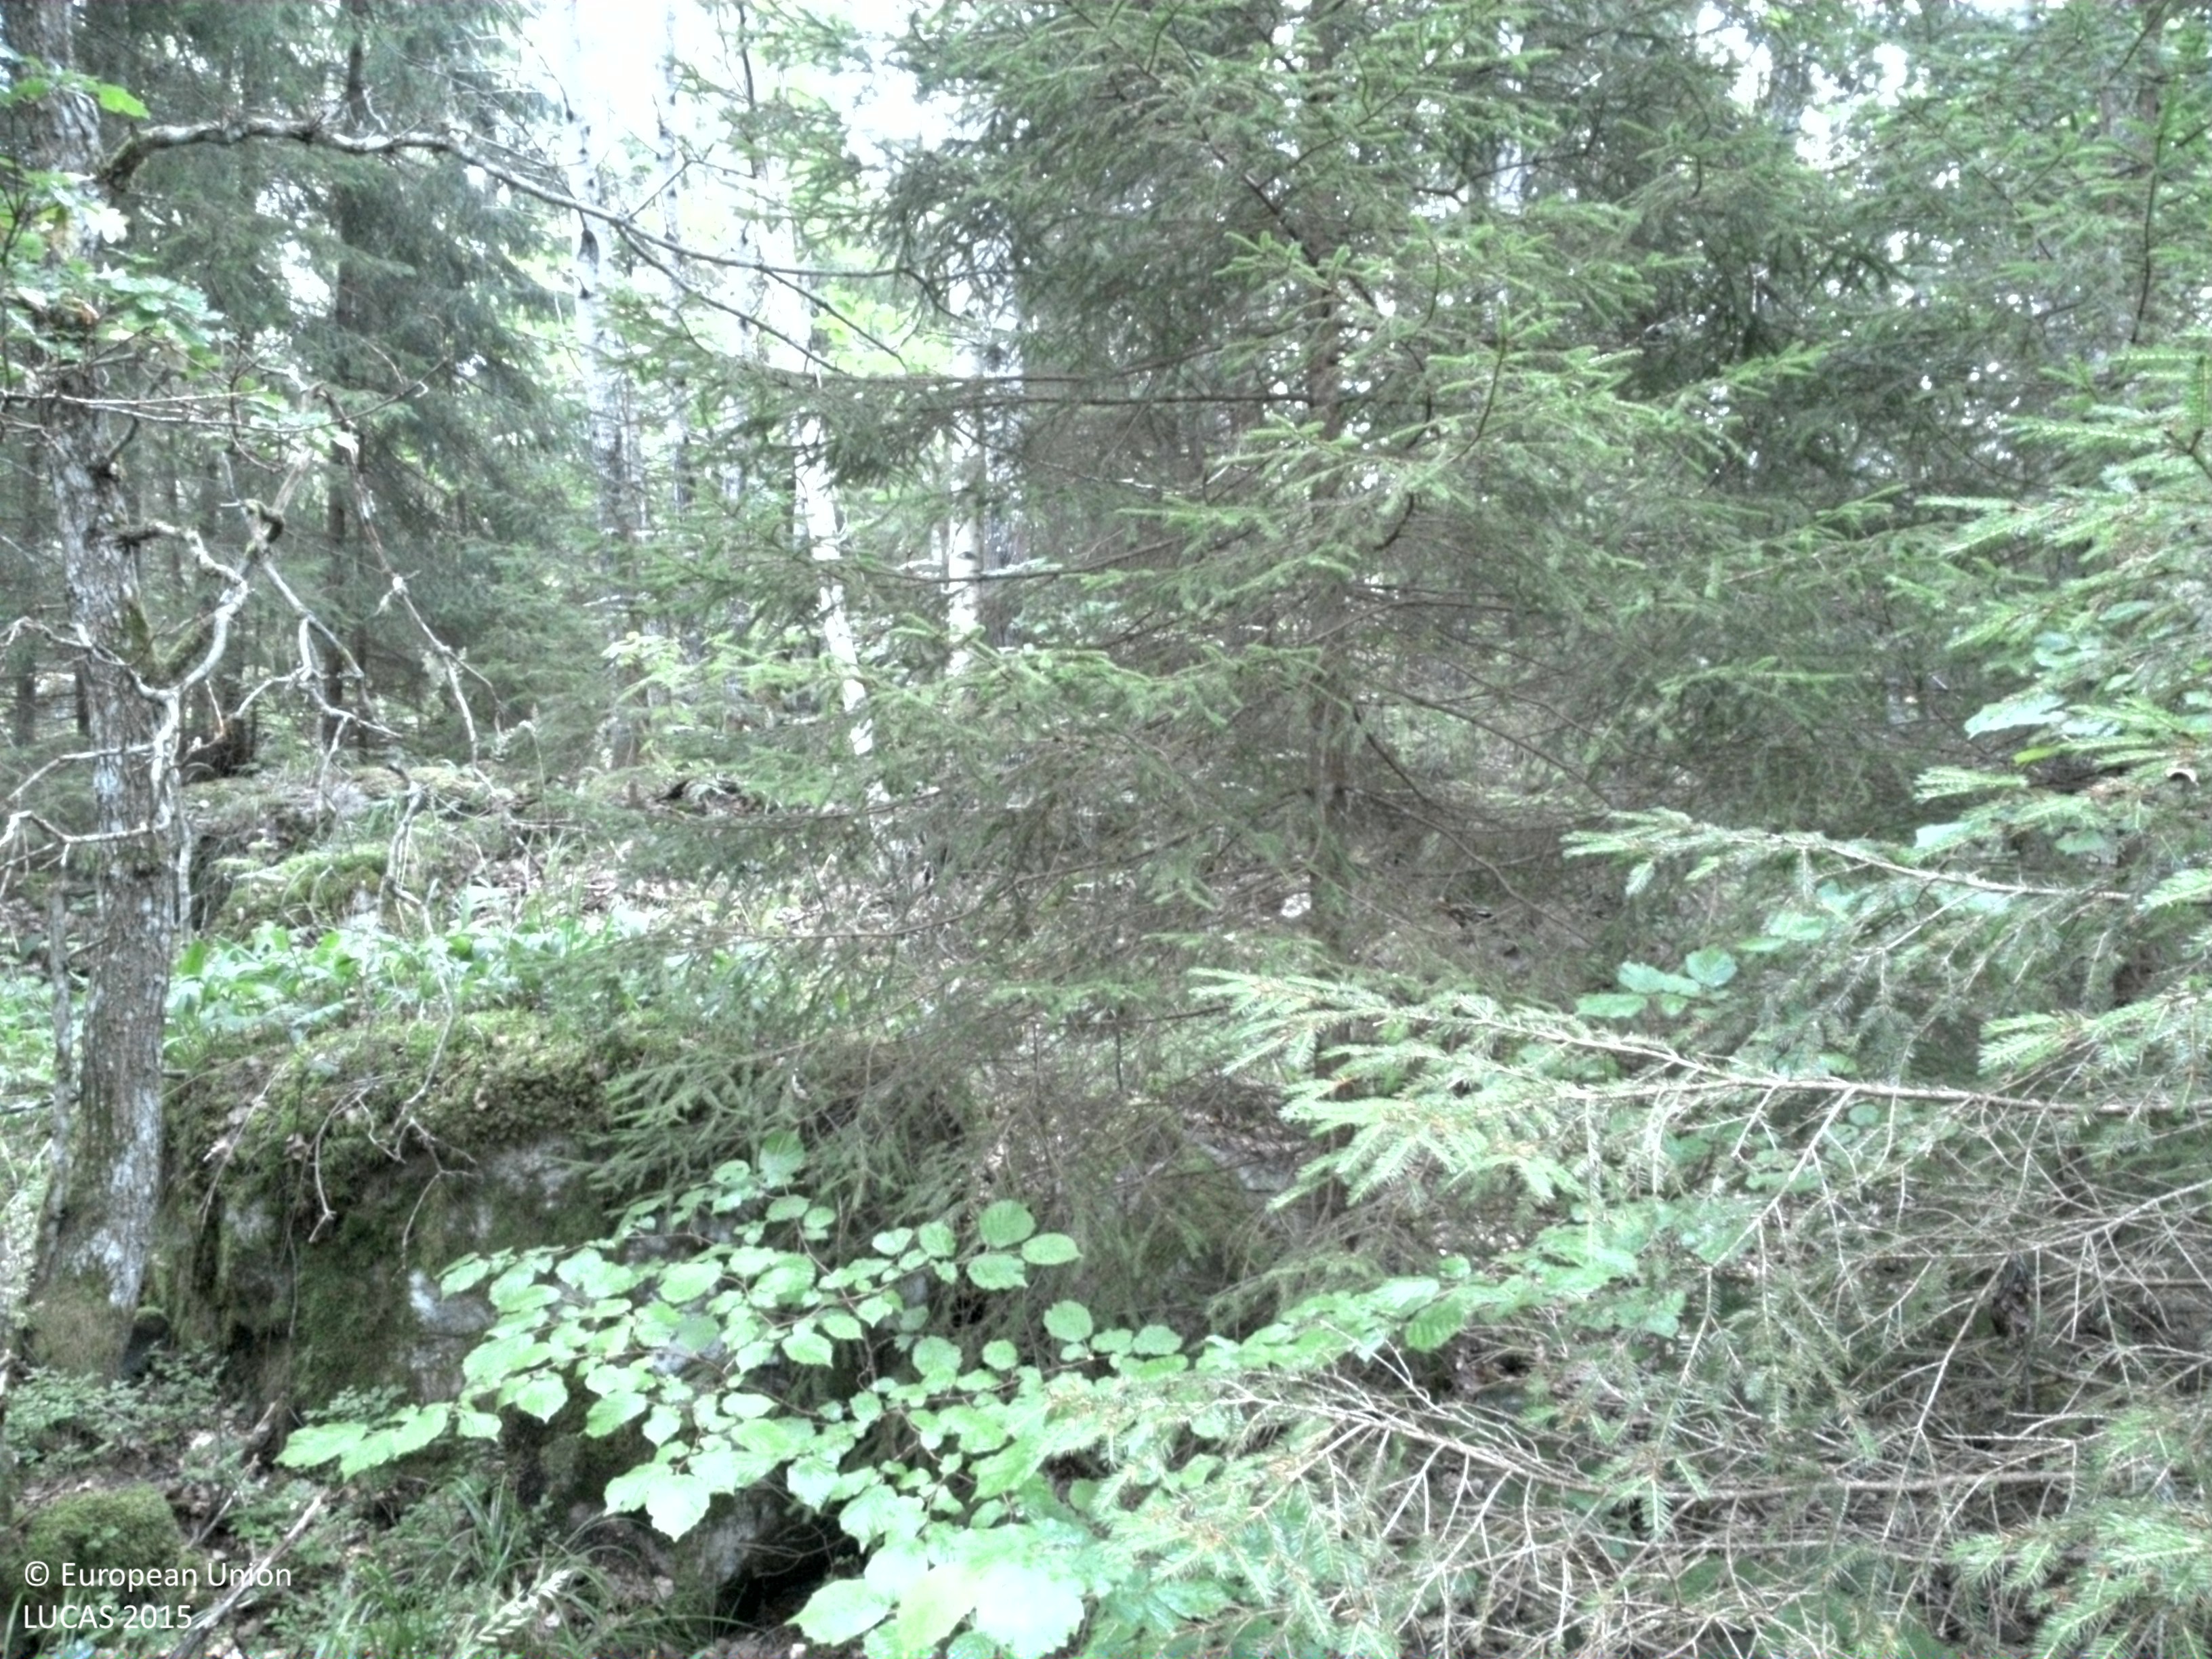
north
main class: Woodland
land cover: Spruce dominated coniferous woodland
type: boreal forest
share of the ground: > 75 %
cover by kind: coniferous forest trees 60 %, herbaceous plants 25 %, broadleaved forest trees 15 %
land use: Forestry
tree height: > 5 m
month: July
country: SE
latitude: 59.8664
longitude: 18.5527
